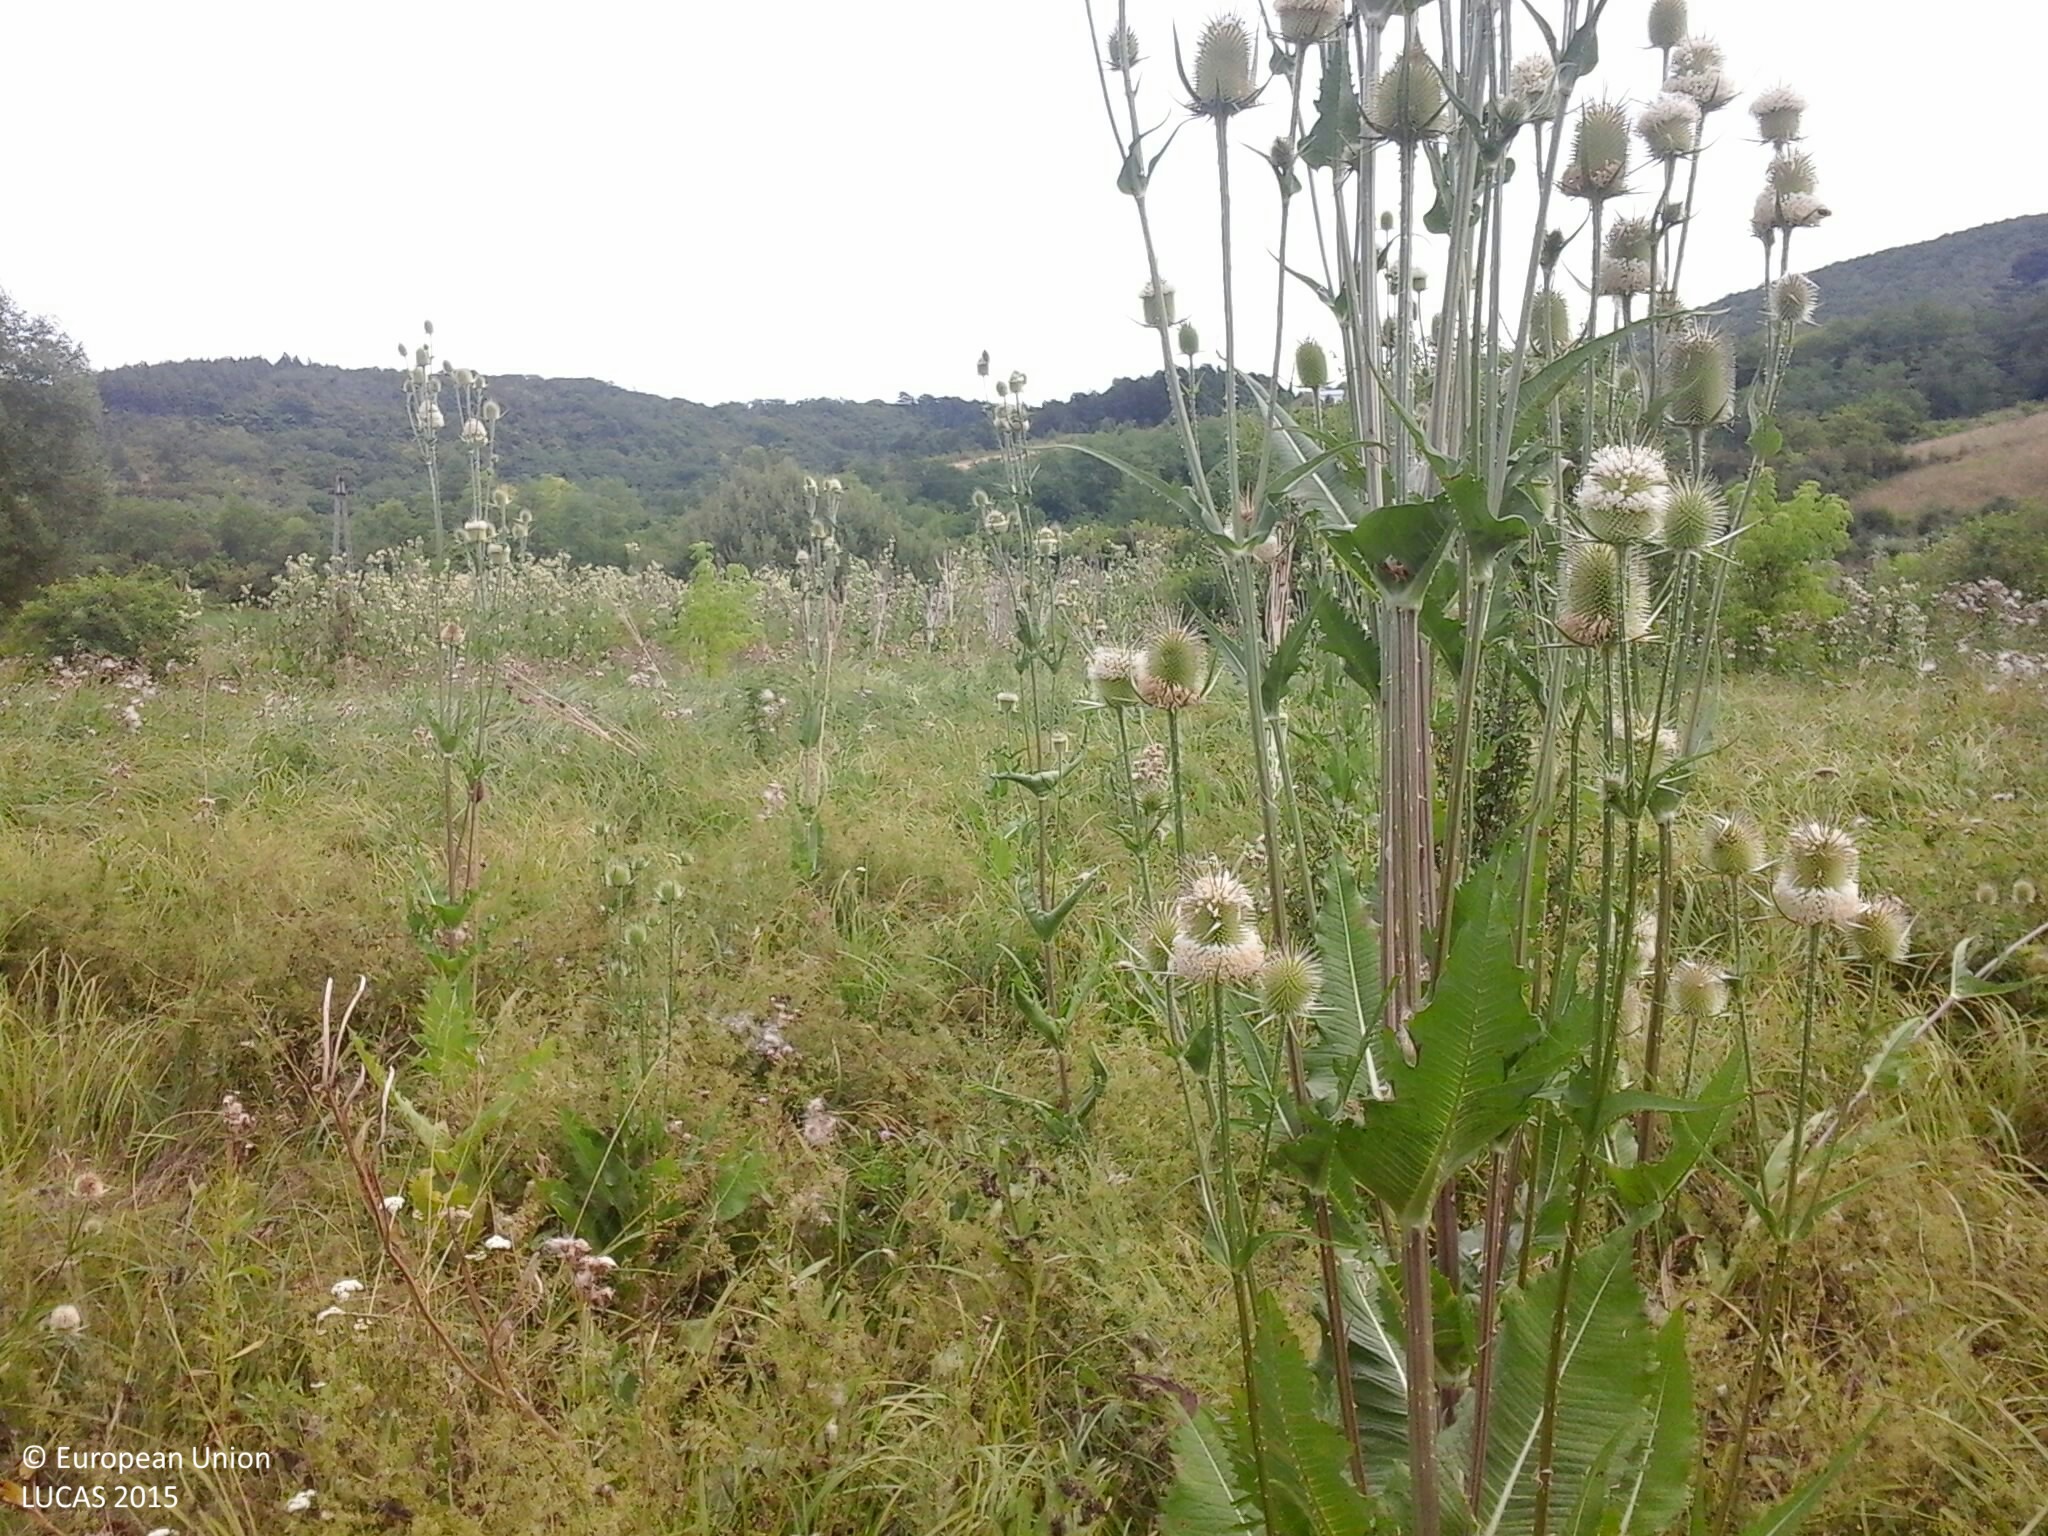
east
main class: Grassland
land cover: Grassland with sparse tree/shrub cover
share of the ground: > 75 %
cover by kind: herbaceous plants 95 %, broadleaved forest trees 5 %
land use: Semi-natural and natural areas not in use
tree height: < 5 m
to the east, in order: Grassland with sparse tree/shrub cover; Shrubland without tree cover; Grassland with sparse tree/shrub cover; Grassland without tree/shrub cover; Lucerne; Electric lines; Lucerne; Broadleaved woodland; Shruby margins; Tracks; Shruby margins; Broadleaved woodland; Spontaneously vegetated surfaces; Shrubland with sparse tree cover; Tracks; Broadleaved woodland; Spontaneously vegetated surfaces
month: July
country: HU
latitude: 47.9229
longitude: 19.2685
